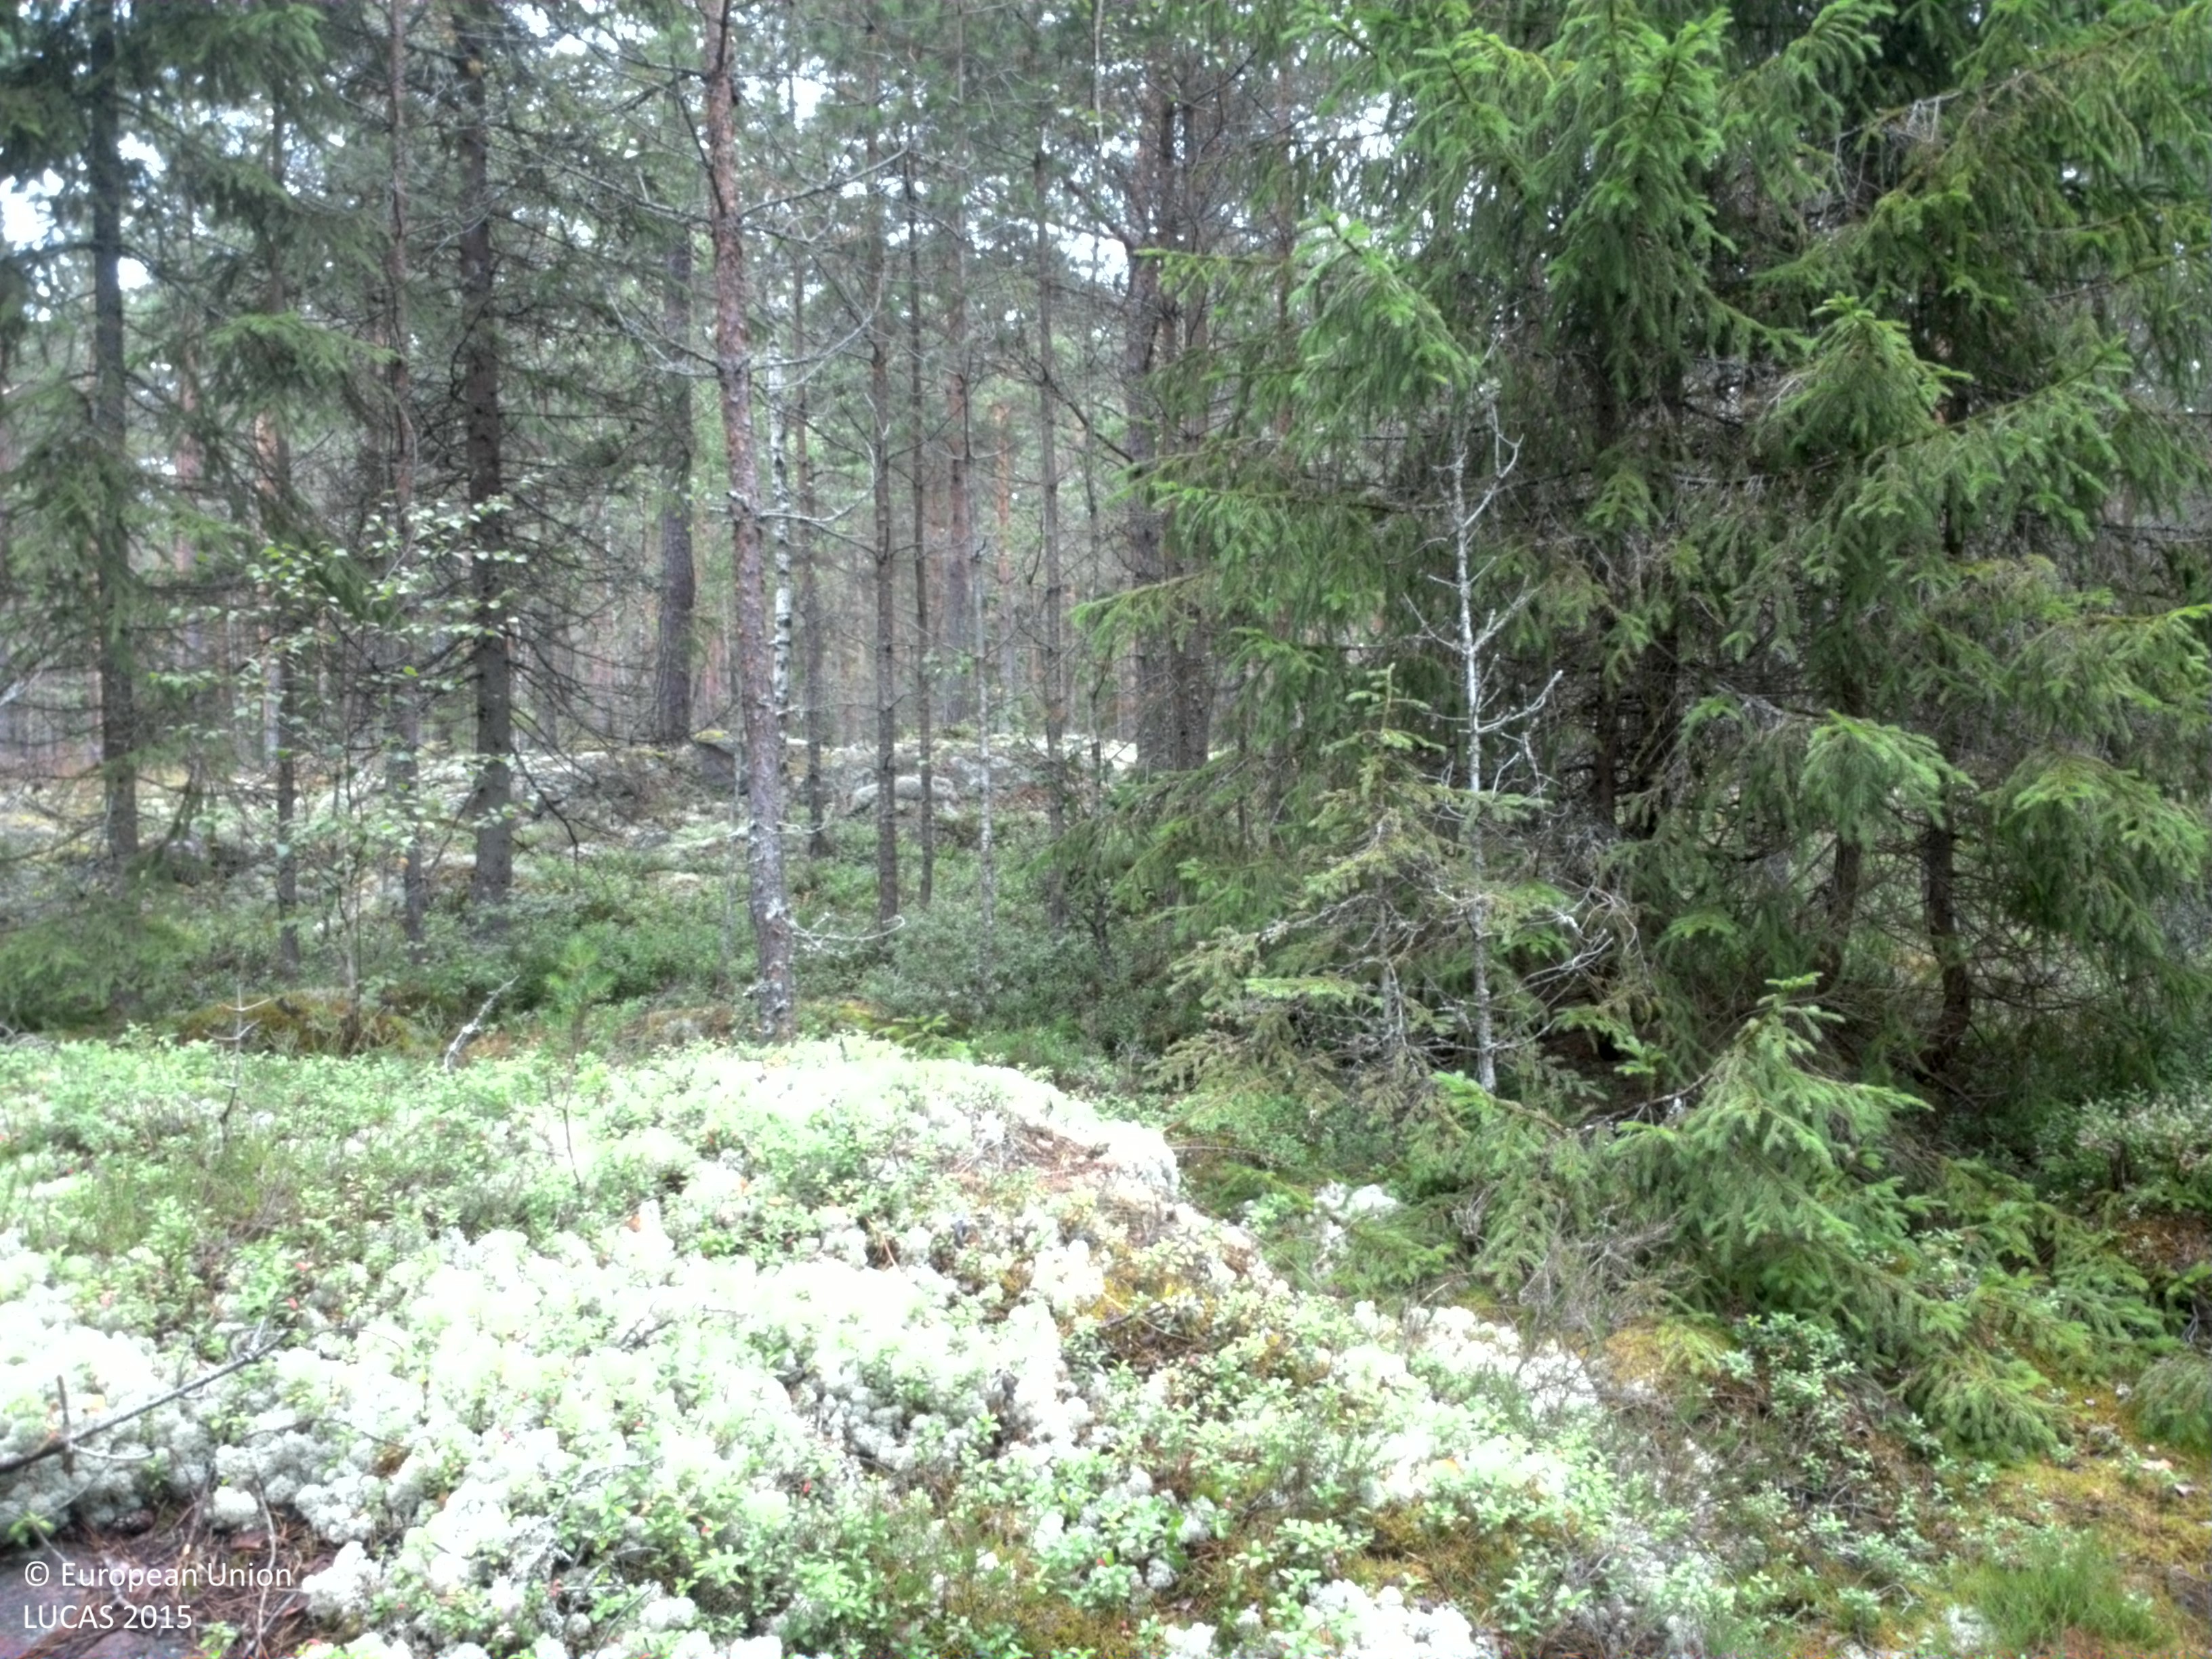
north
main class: Woodland
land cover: Pine dominated coniferous woodland
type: boreal forest
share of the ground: 50 - 75 %
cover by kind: coniferous forest trees 55 %, shrubs 20 %, lichens and mosses 20 %, broadleaved forest trees 5 %
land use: Forestry
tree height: > 5 m
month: July
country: SE
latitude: 59.4397
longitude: 13.2897
